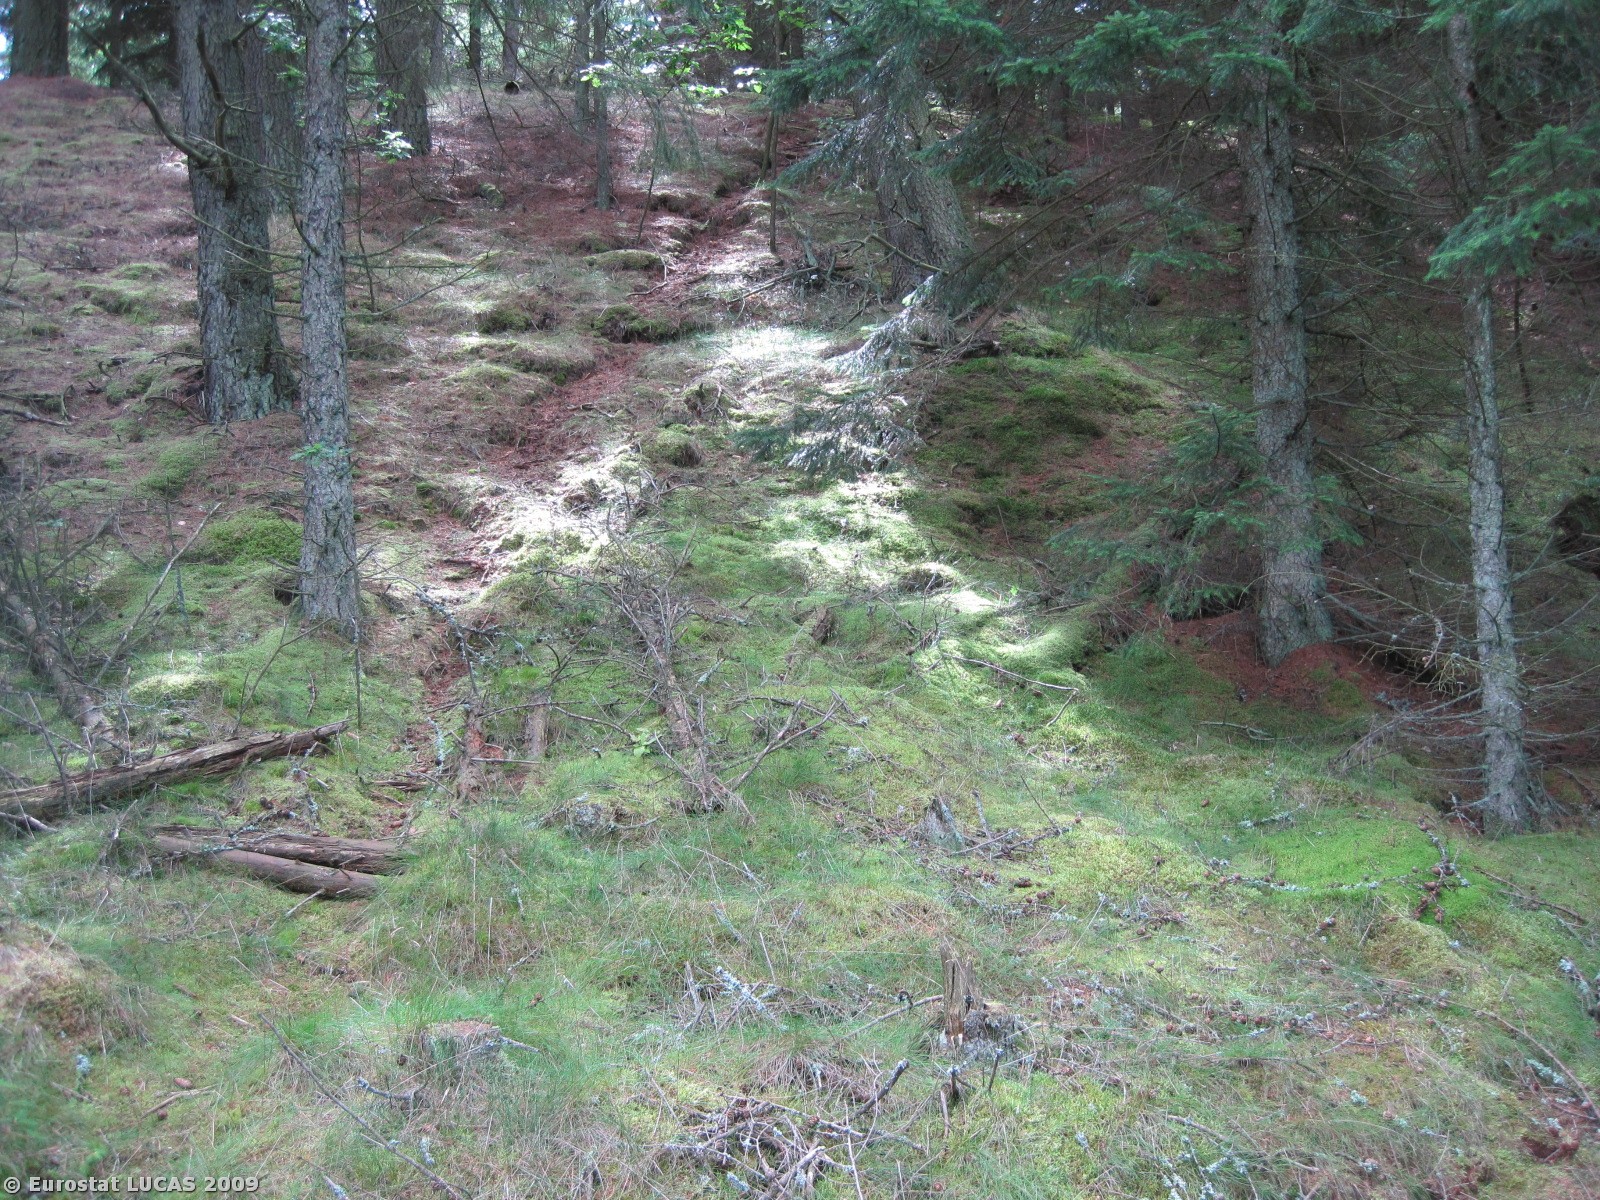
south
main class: Woodland
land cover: Coniferous woodland
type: plantations and self-sown exotic forest
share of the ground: 50 - 75 %
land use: Forestry
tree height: > 5 m
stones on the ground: < 10 %
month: July
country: DK
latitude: 57.0825
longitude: 8.9621
